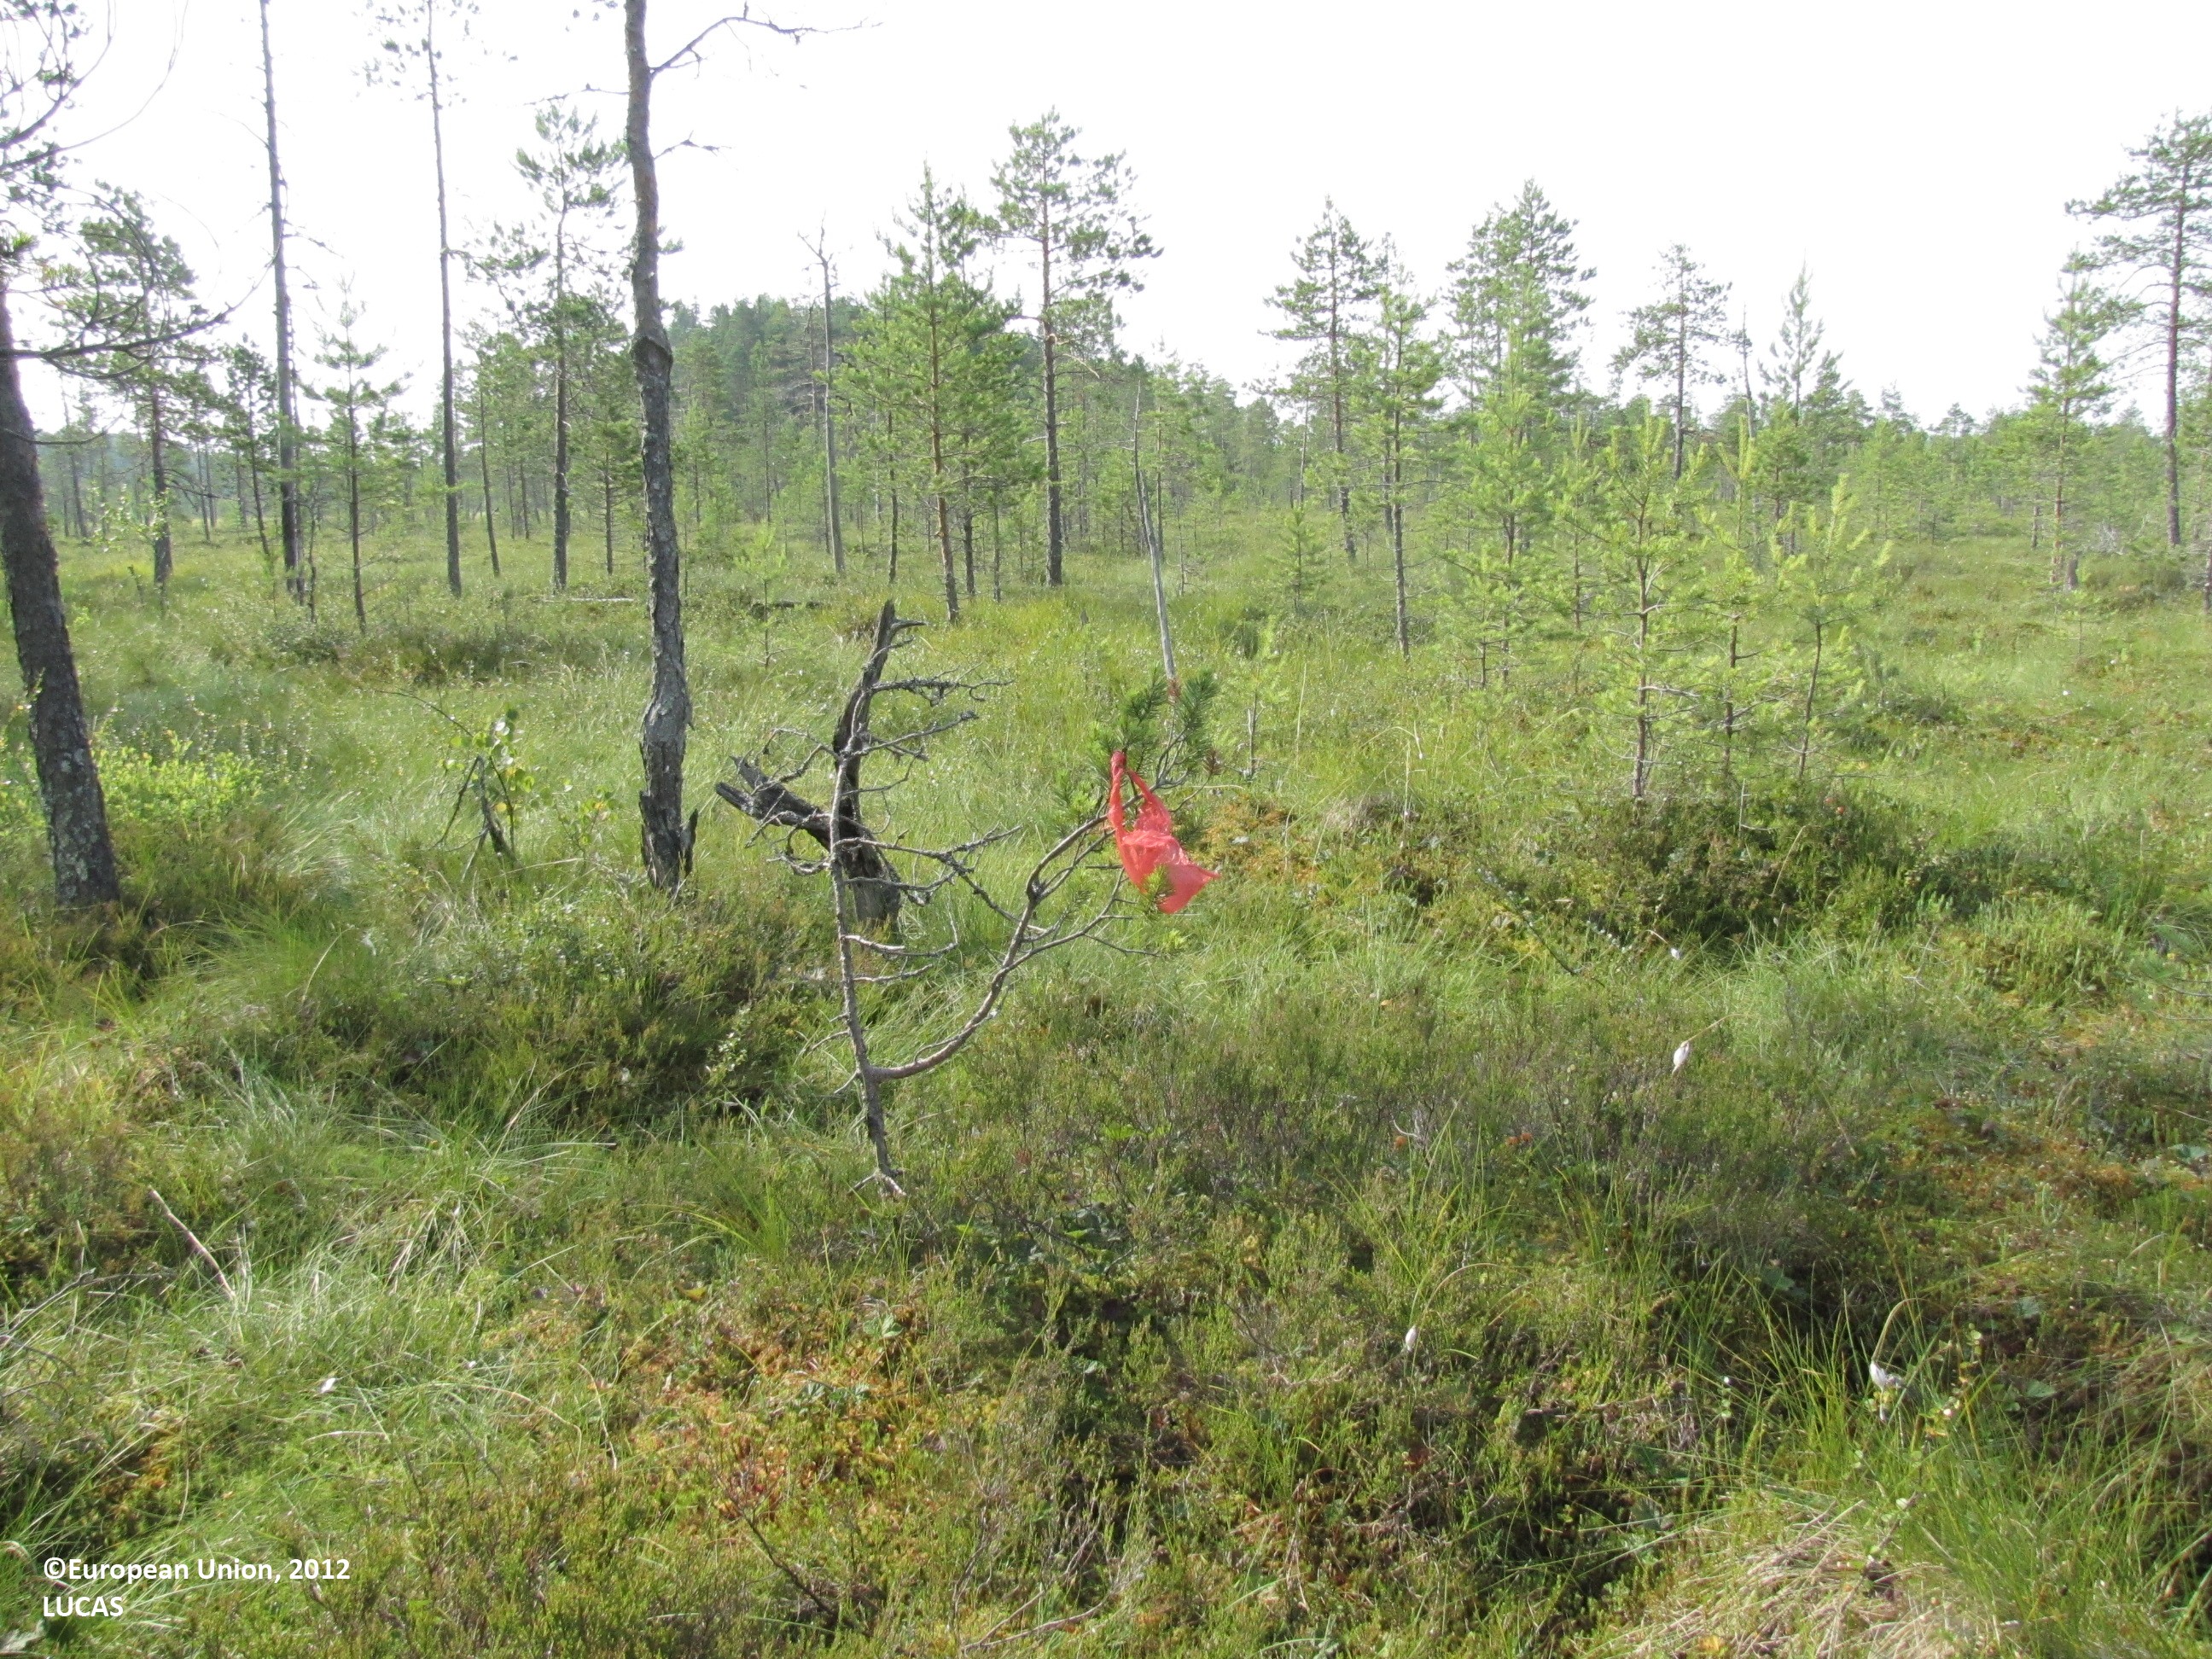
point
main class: Woodland
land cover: Pine dominated coniferous woodland
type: mire and swamp forests
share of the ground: 25 - 50 %
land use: Community services
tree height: < 5 m
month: July
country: FI
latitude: 62.0566
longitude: 23.2896
